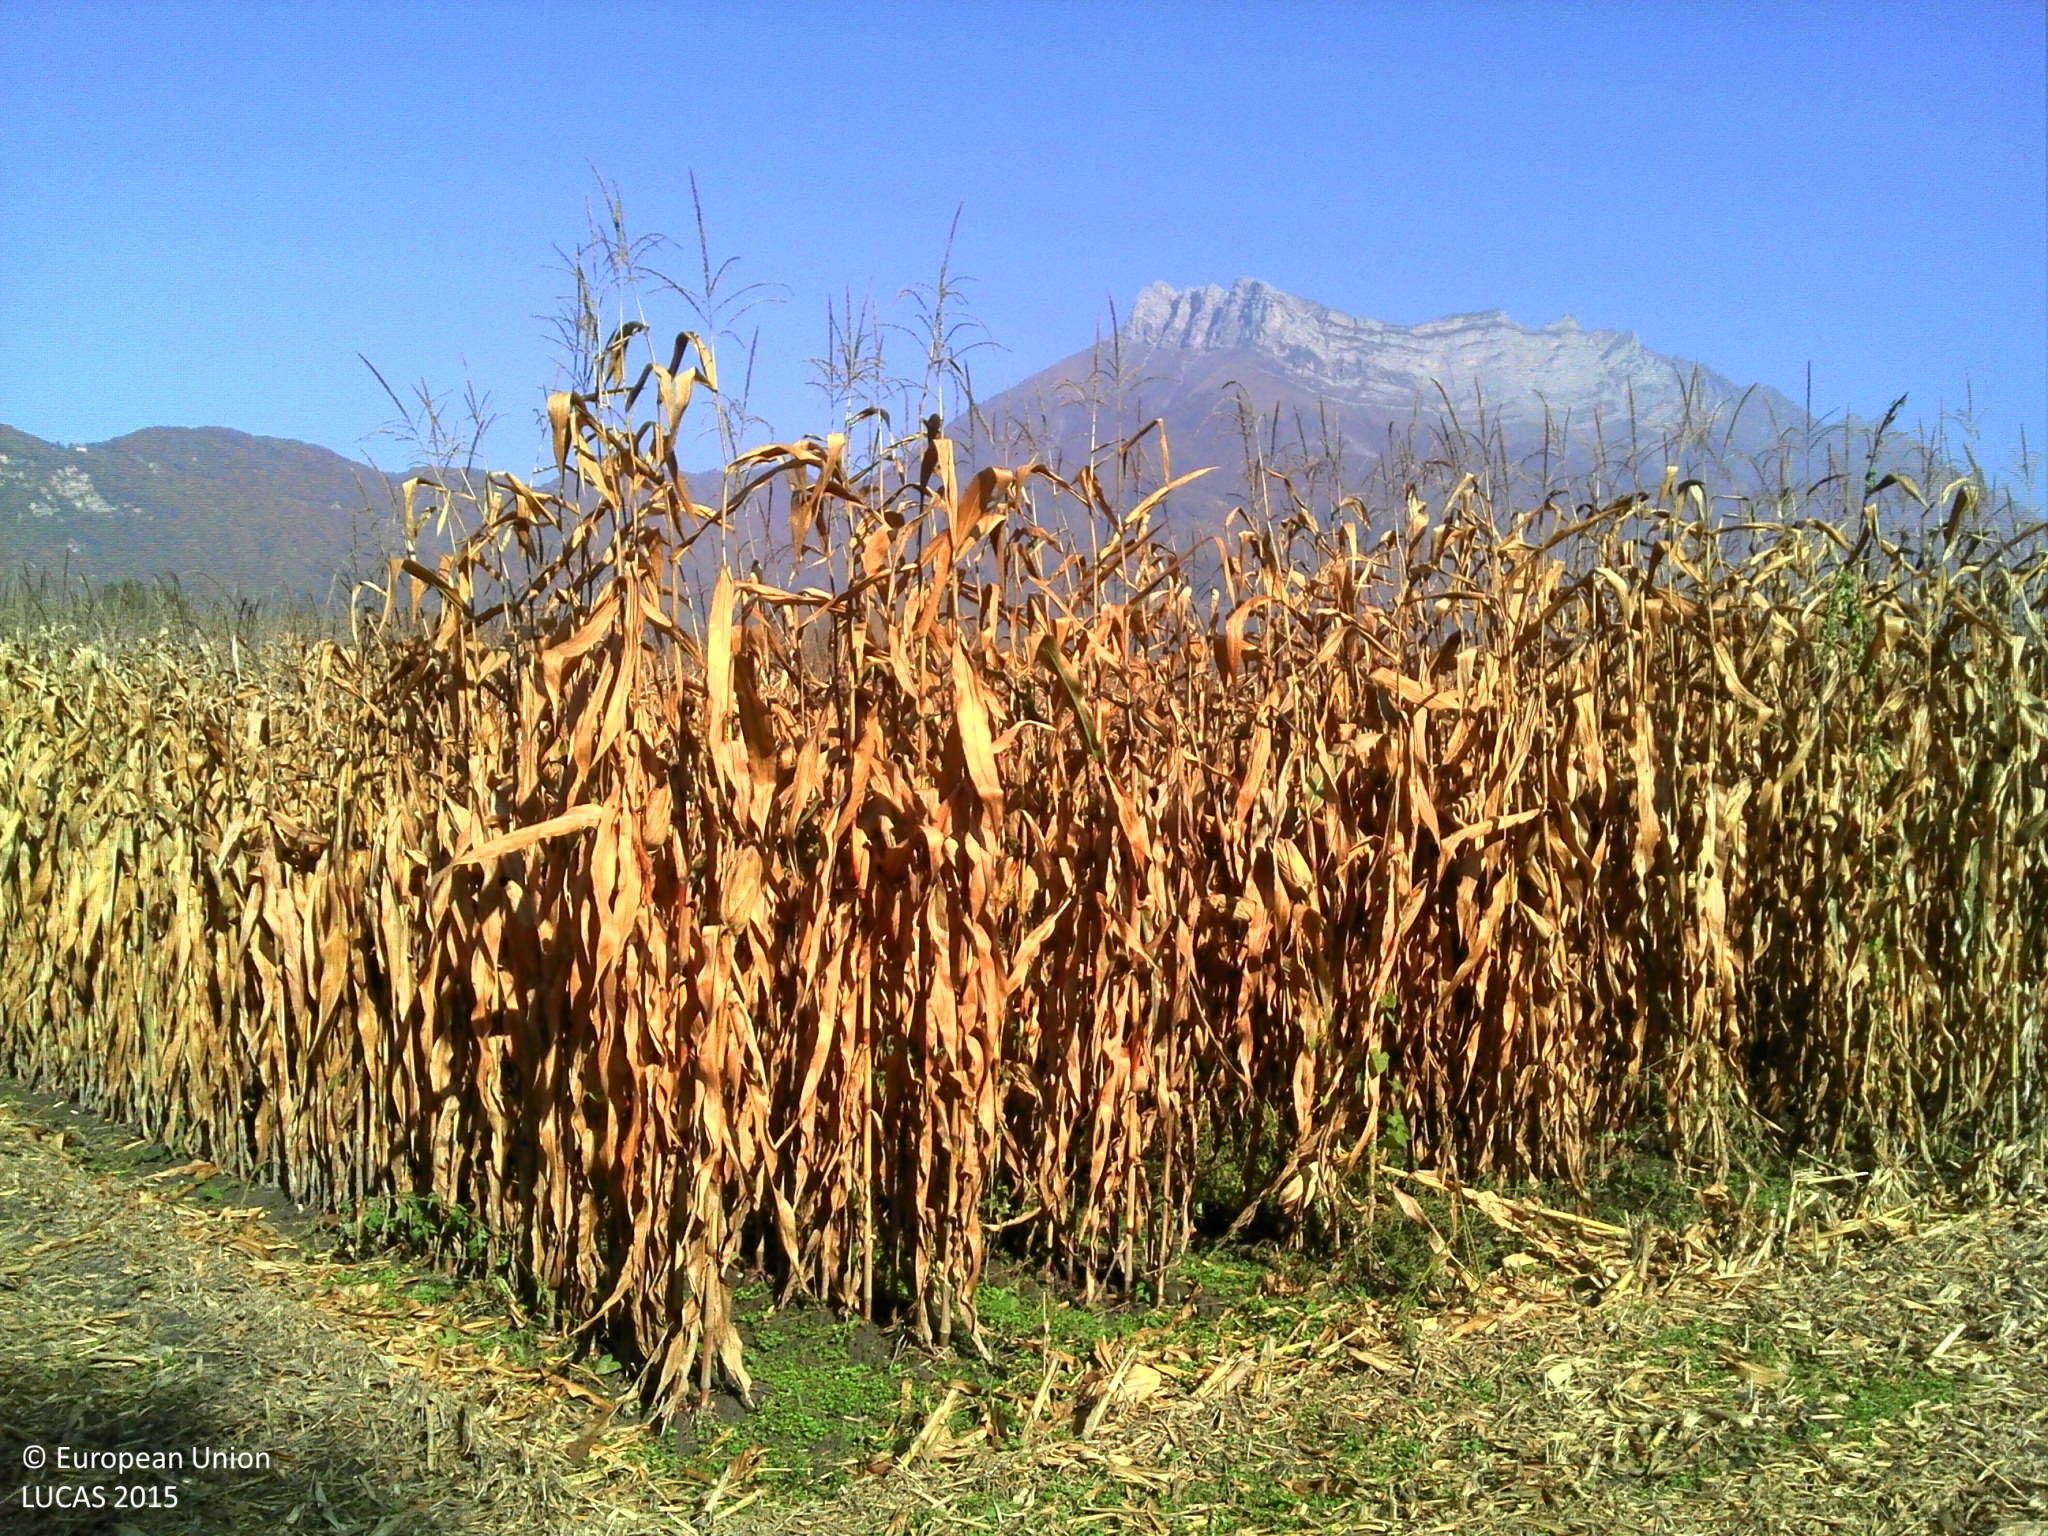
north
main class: Cropland
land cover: Maize
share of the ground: > 75 %
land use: Agriculture (excluding fallow land and kitchen gardens)
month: October
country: FR
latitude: 45.5425
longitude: 6.1496
